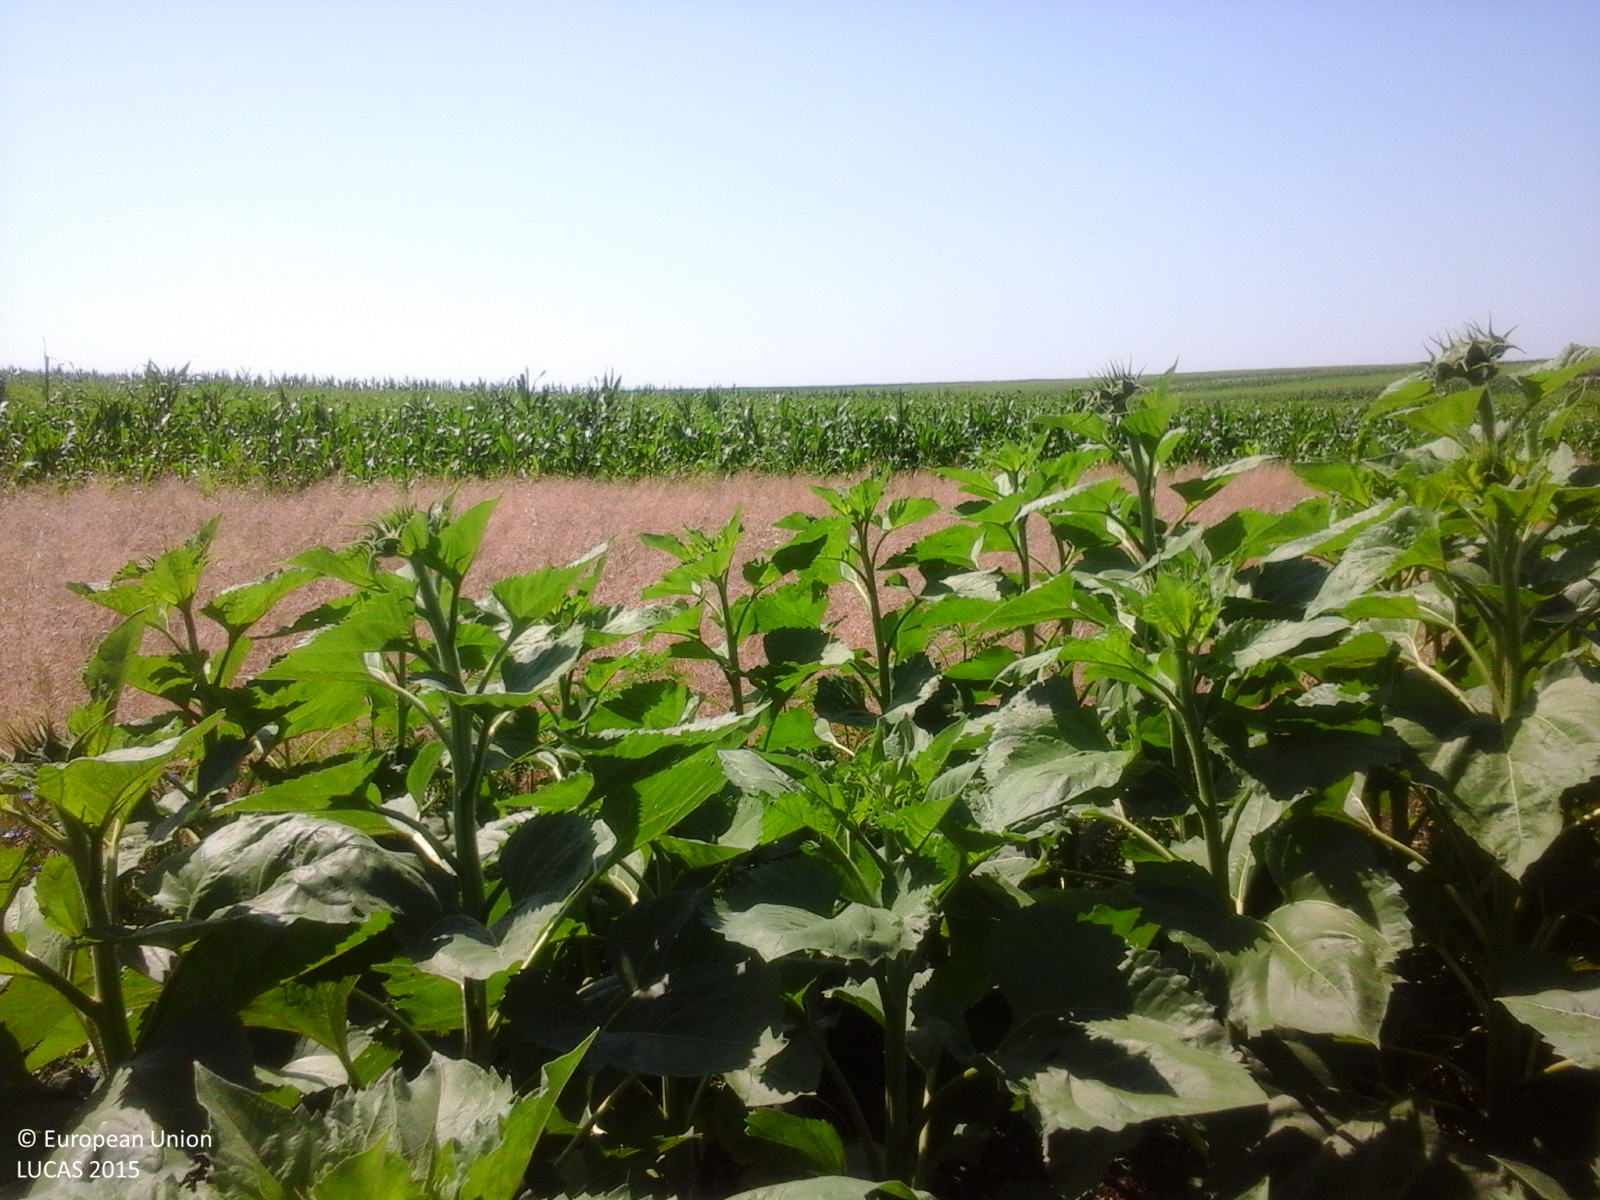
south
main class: Cropland
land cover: Sunflower
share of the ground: > 75 %
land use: Agriculture (excluding fallow land and kitchen gardens)
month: July
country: RO
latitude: 44.5293
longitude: 24.5301
